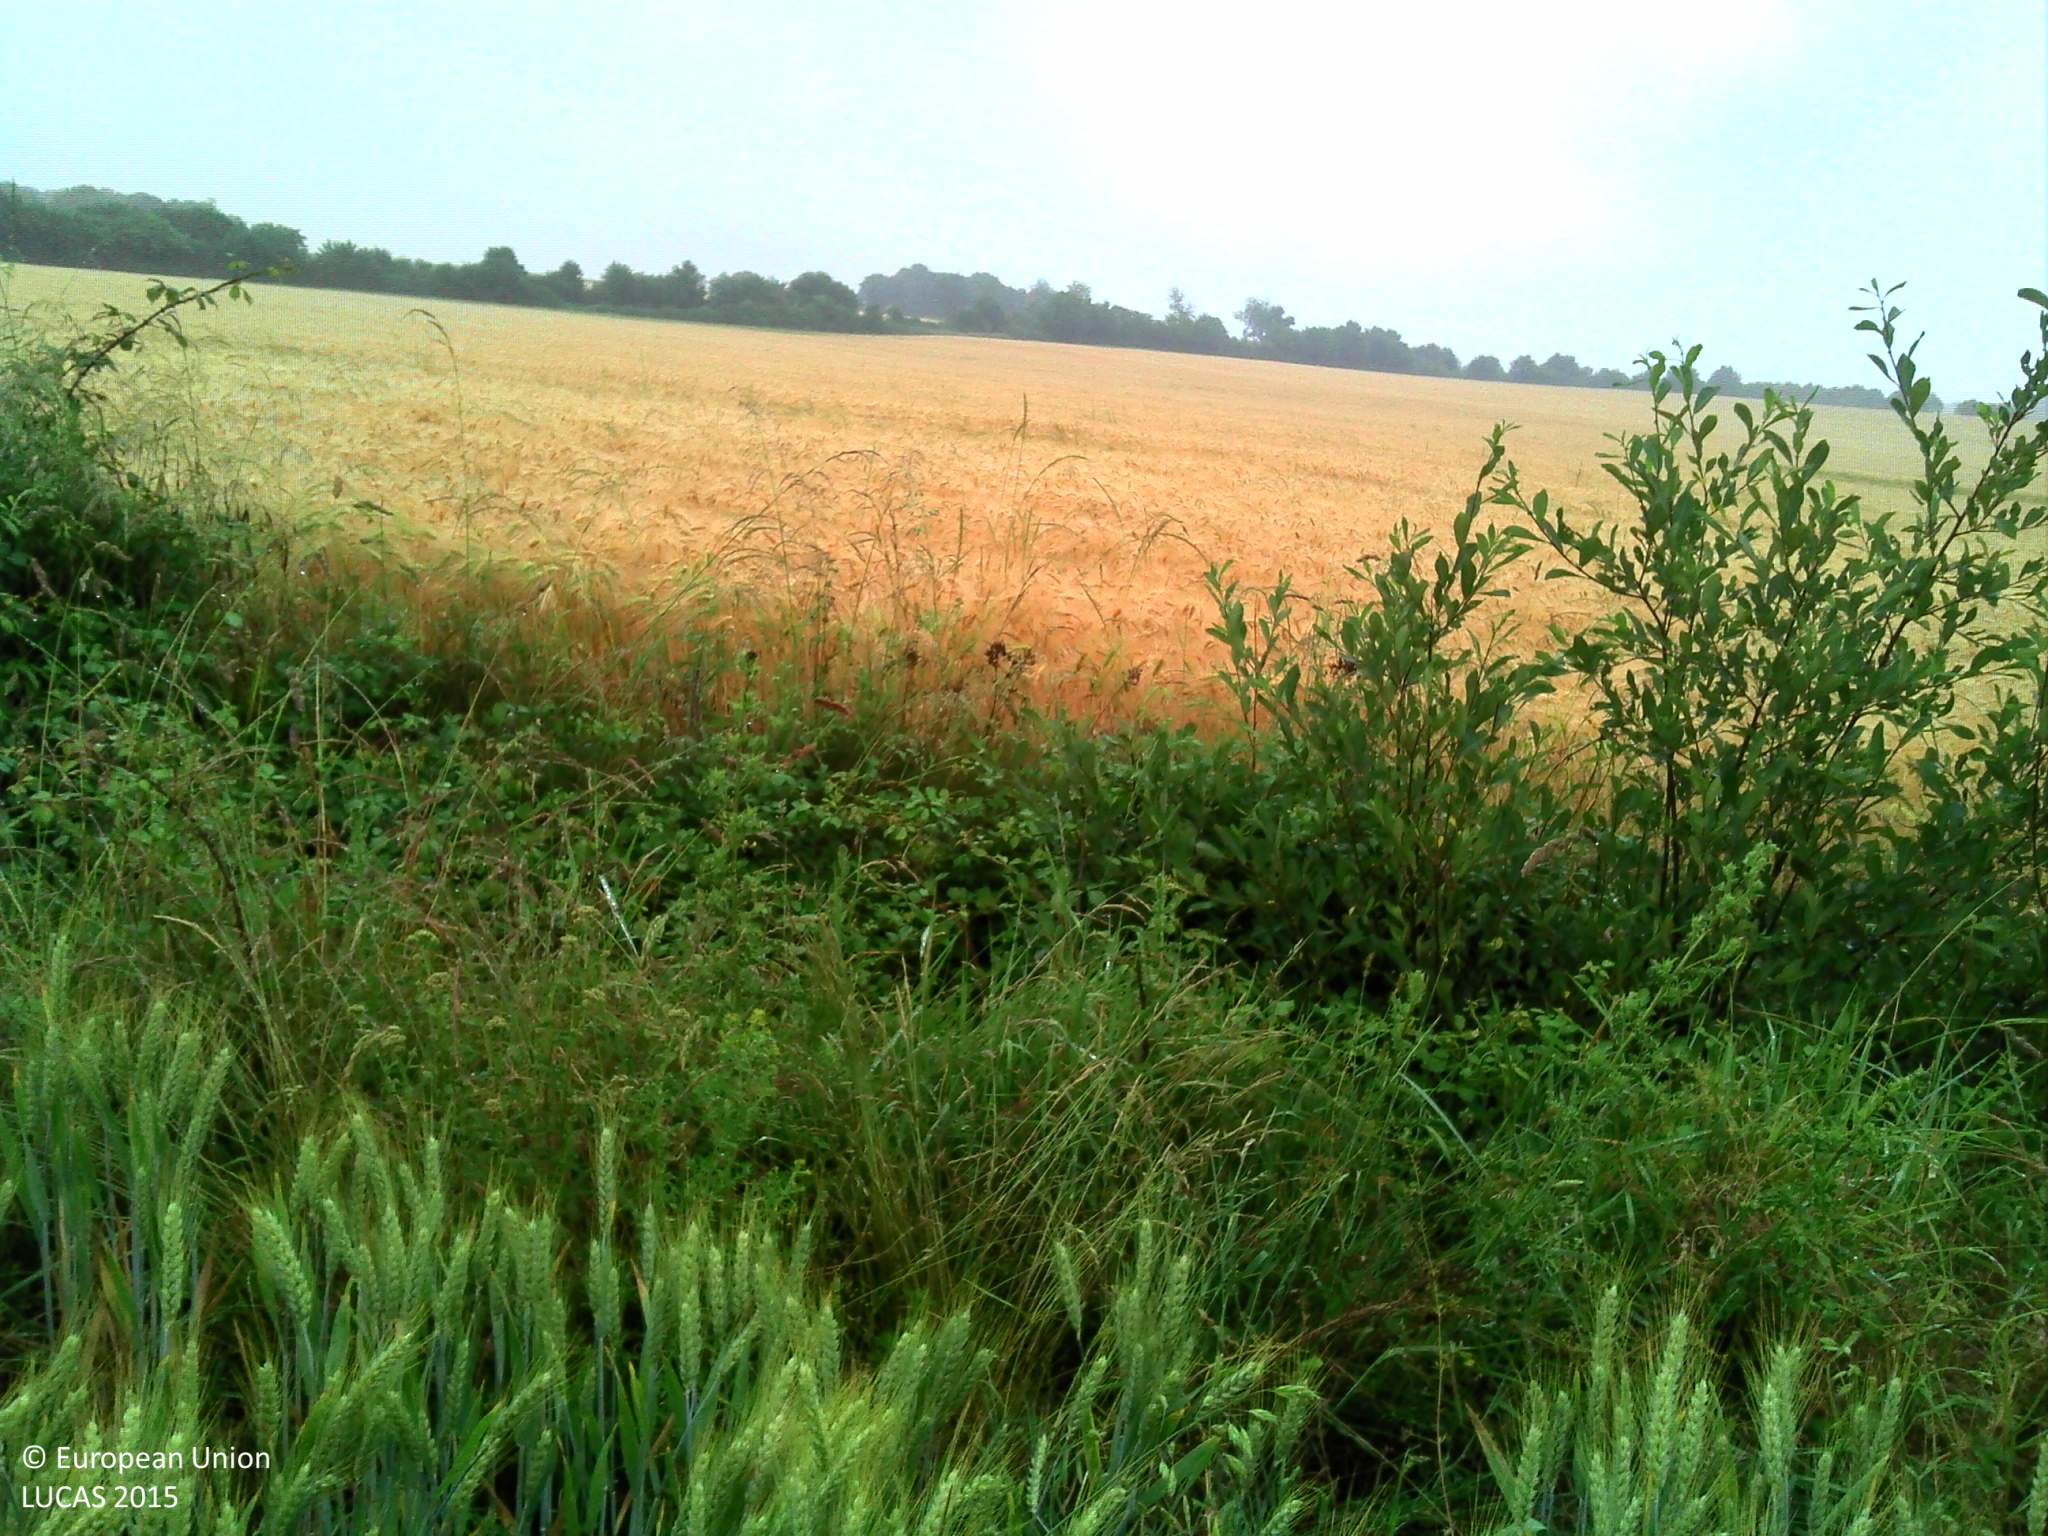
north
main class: Cropland
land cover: Common wheat
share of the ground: > 75 %
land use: Agriculture (excluding fallow land and kitchen gardens)
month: June
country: FR
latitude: 47.4724
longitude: 2.6554
